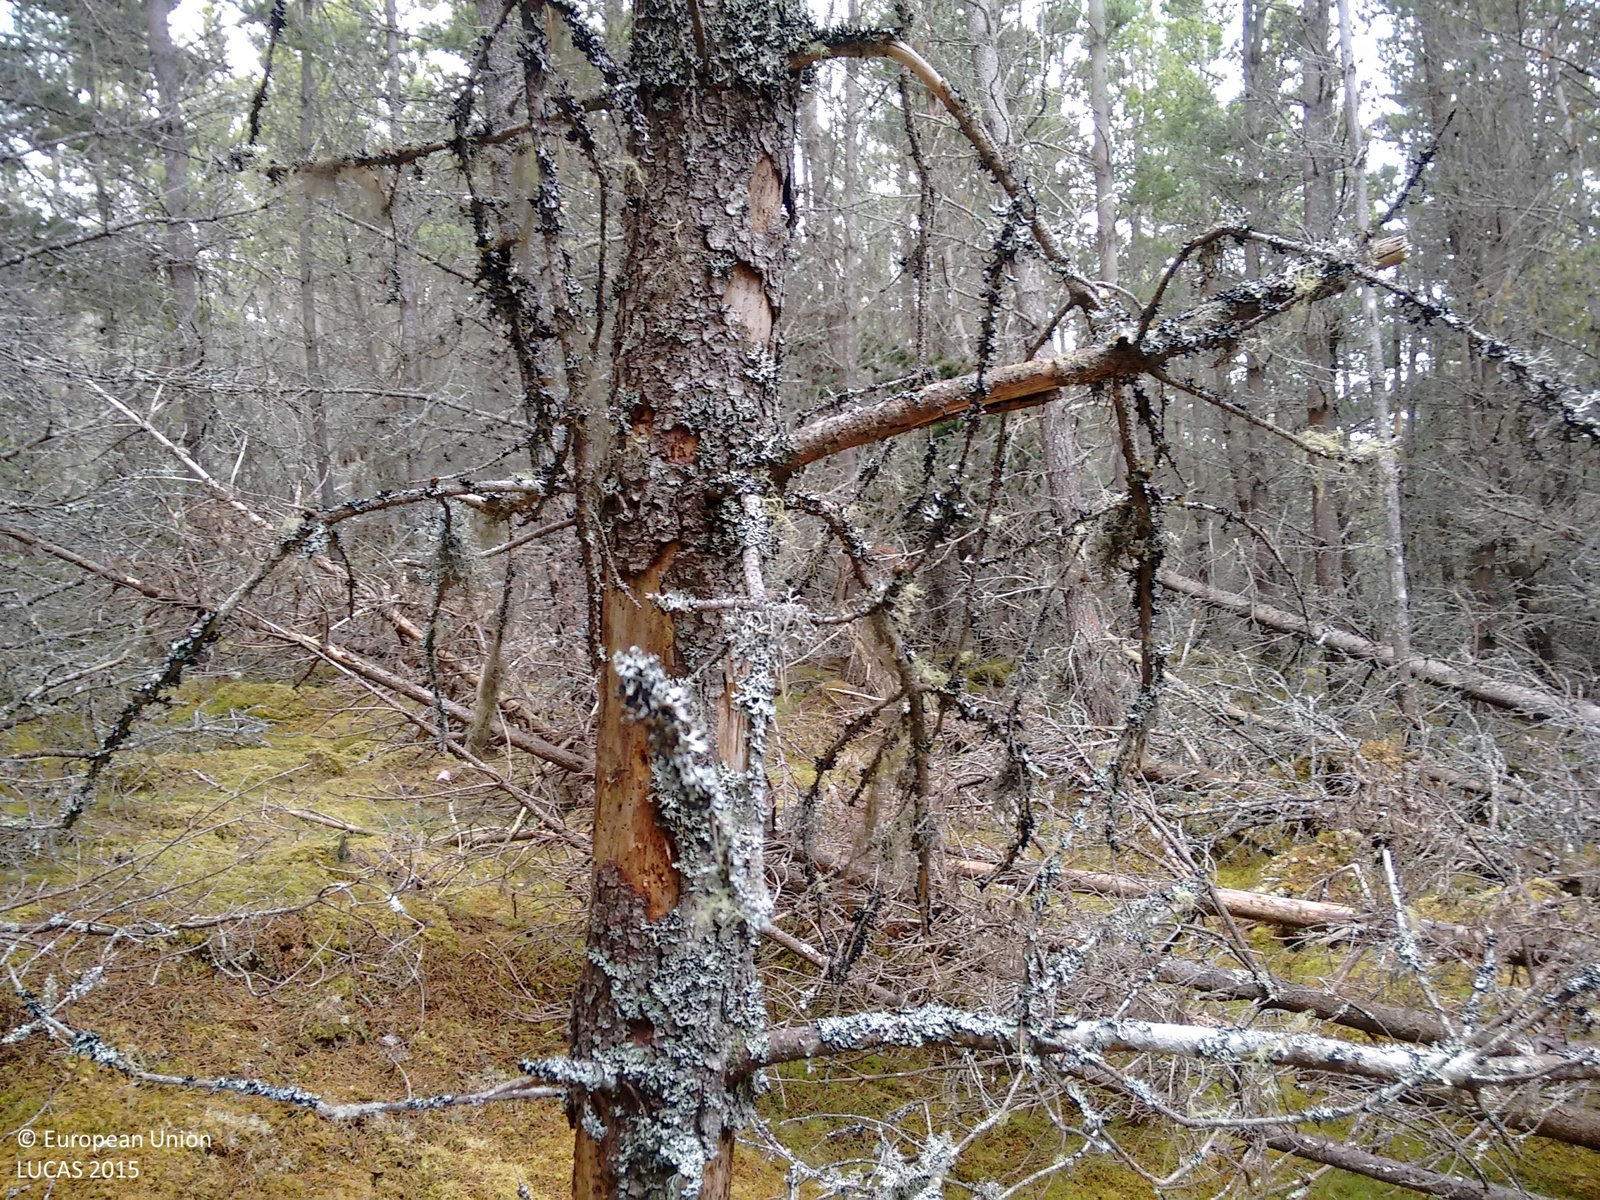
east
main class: Woodland
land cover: Pine dominated coniferous woodland
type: exotic forest
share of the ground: 50 - 75 %
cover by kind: coniferous forest trees 60 %, lichens and mosses 40 %
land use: Forestry
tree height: > 5 m
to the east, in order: Pine dominated coniferous woodland; Lichens and moss; Pine dominated coniferous woodland
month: June
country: GB
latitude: 57.2768
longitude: -3.8617
